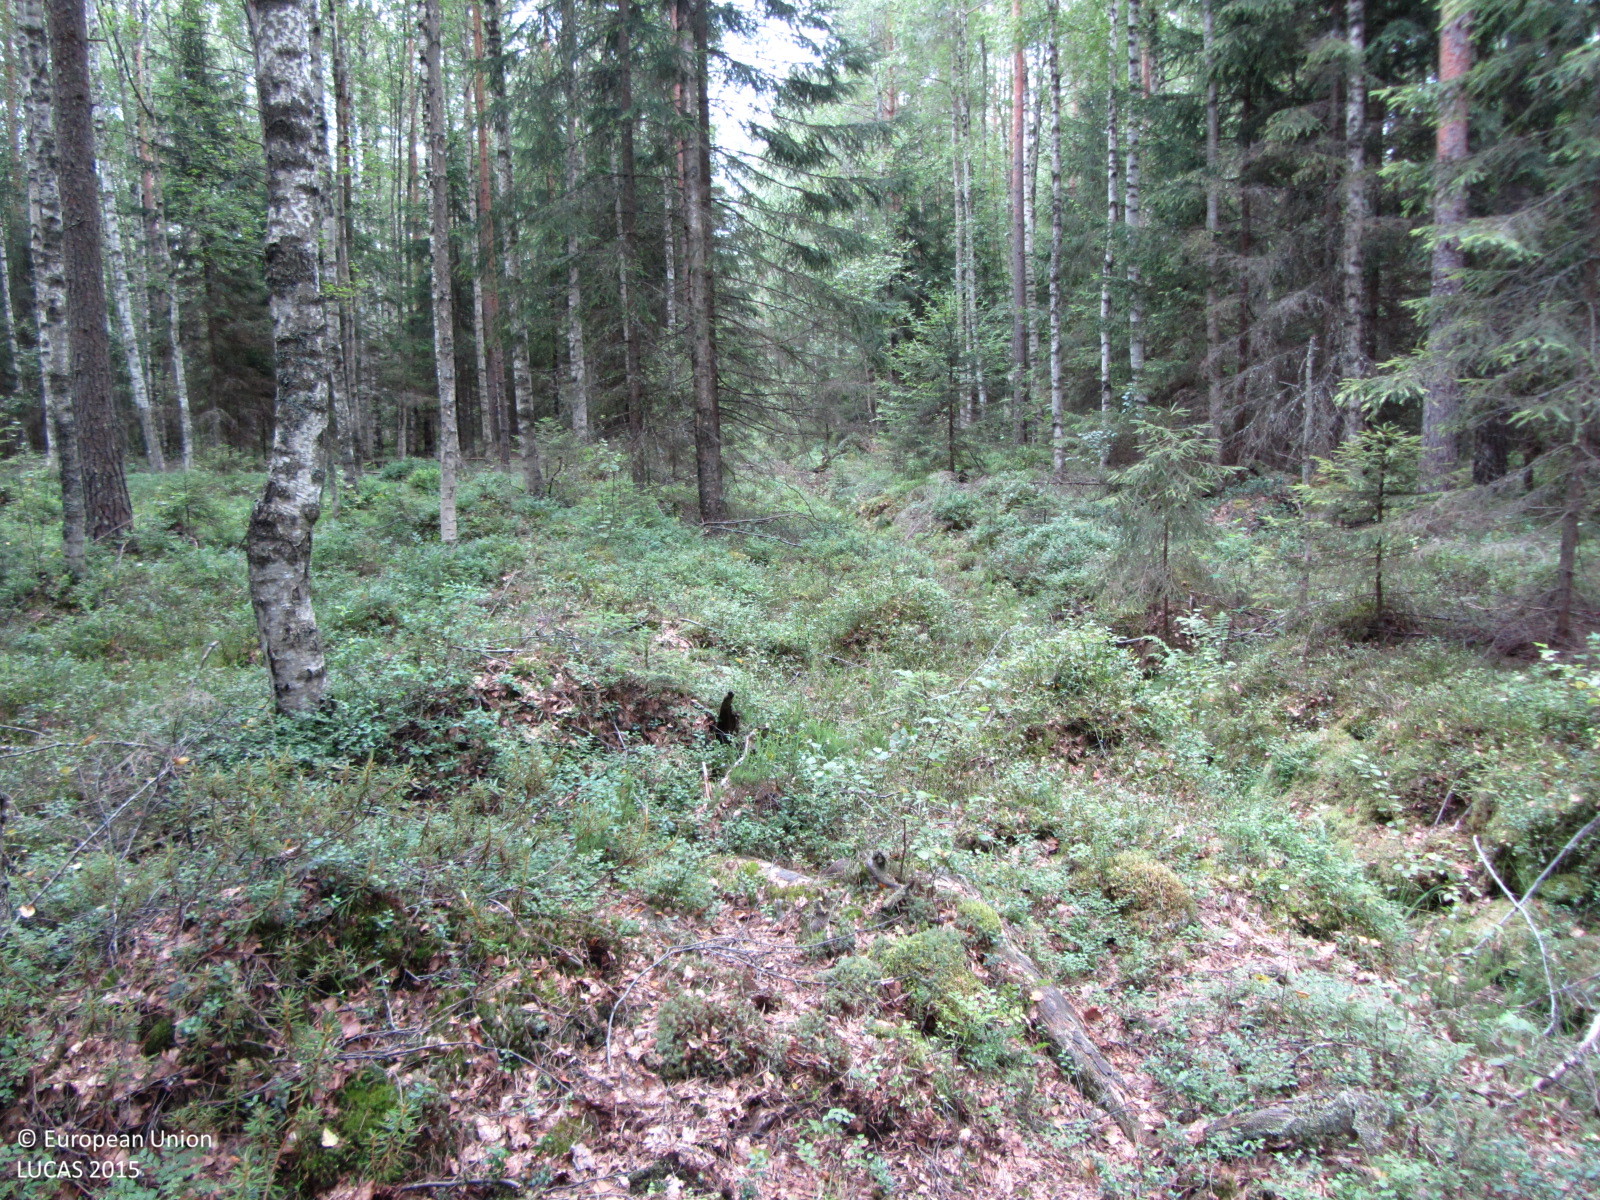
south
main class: Woodland
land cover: Other mixed woodland
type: boreal forest
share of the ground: > 75 %
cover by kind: coniferous forest trees 45 %, broadleaved forest trees 40 %, shrubs 15 %
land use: Forestry
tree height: > 5 m
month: July
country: FI
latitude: 60.5469
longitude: 24.3045
